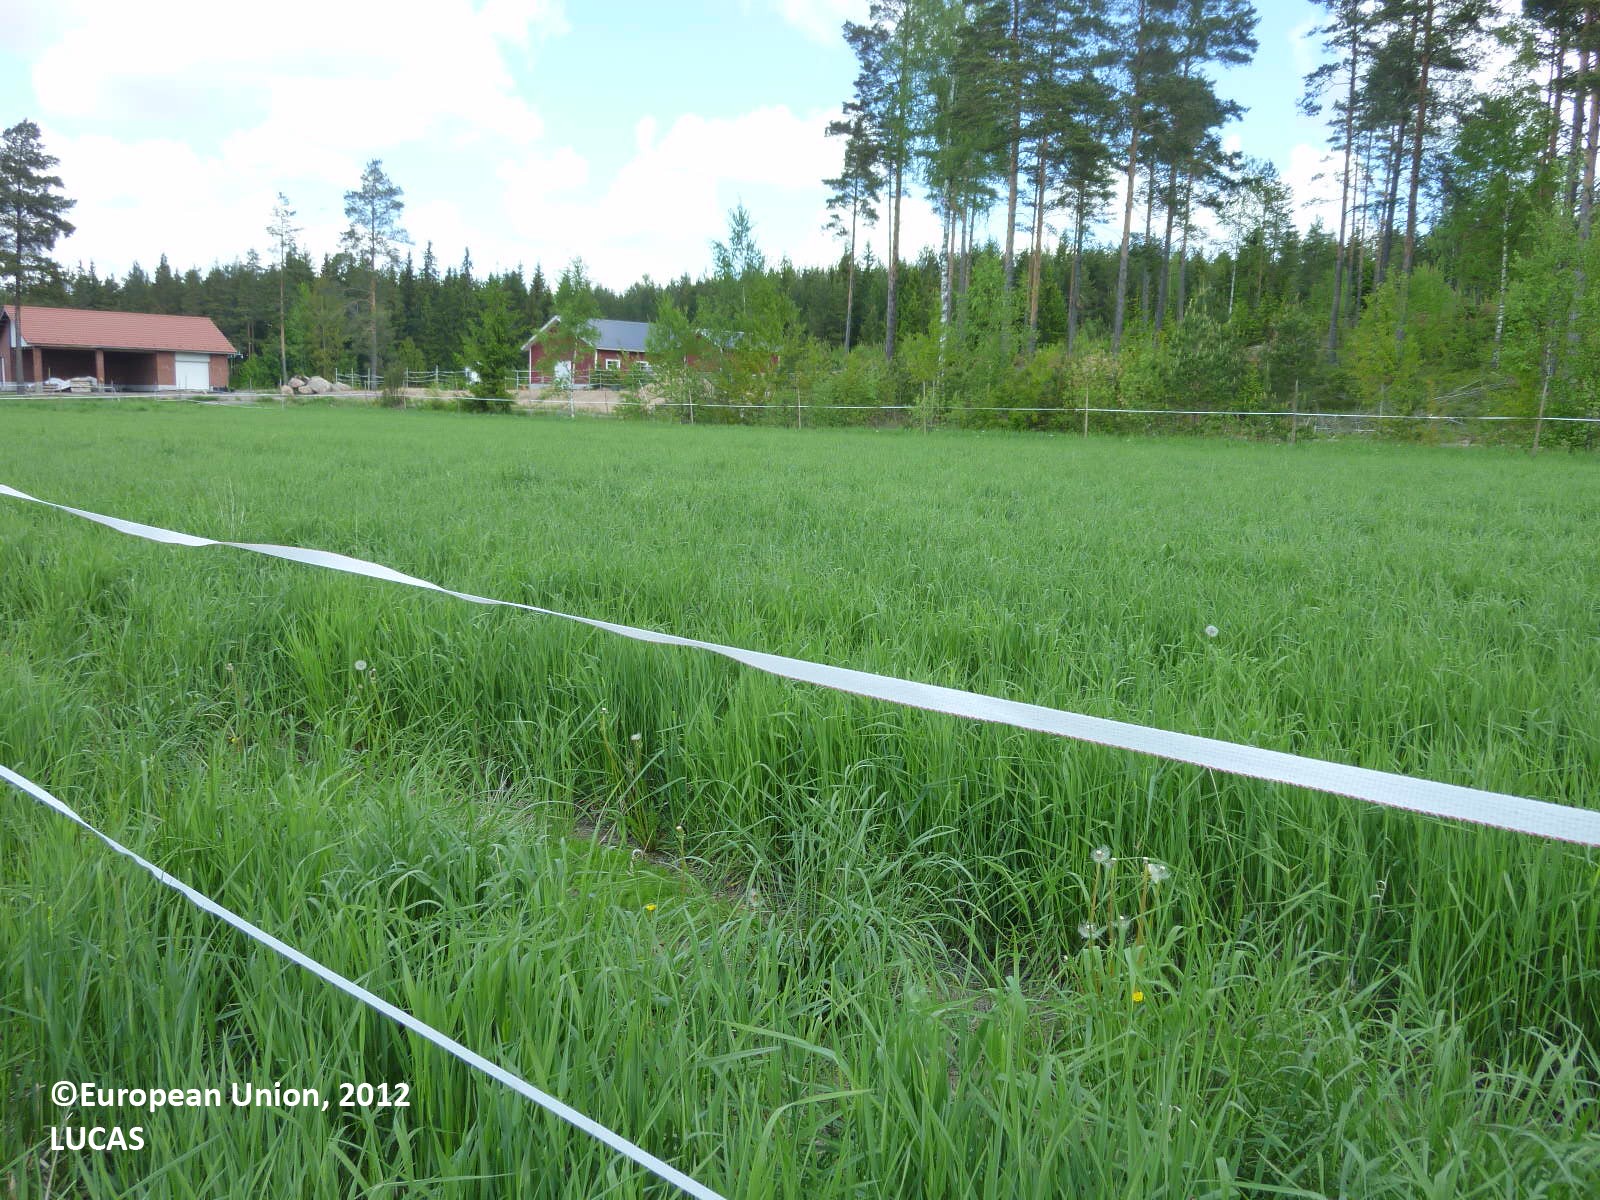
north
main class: Cropland
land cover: Barley
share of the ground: < 10 %
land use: Agriculture (excluding fallow land and kitchen gardens)
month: June
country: FI
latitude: 60.4950
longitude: 22.5397
